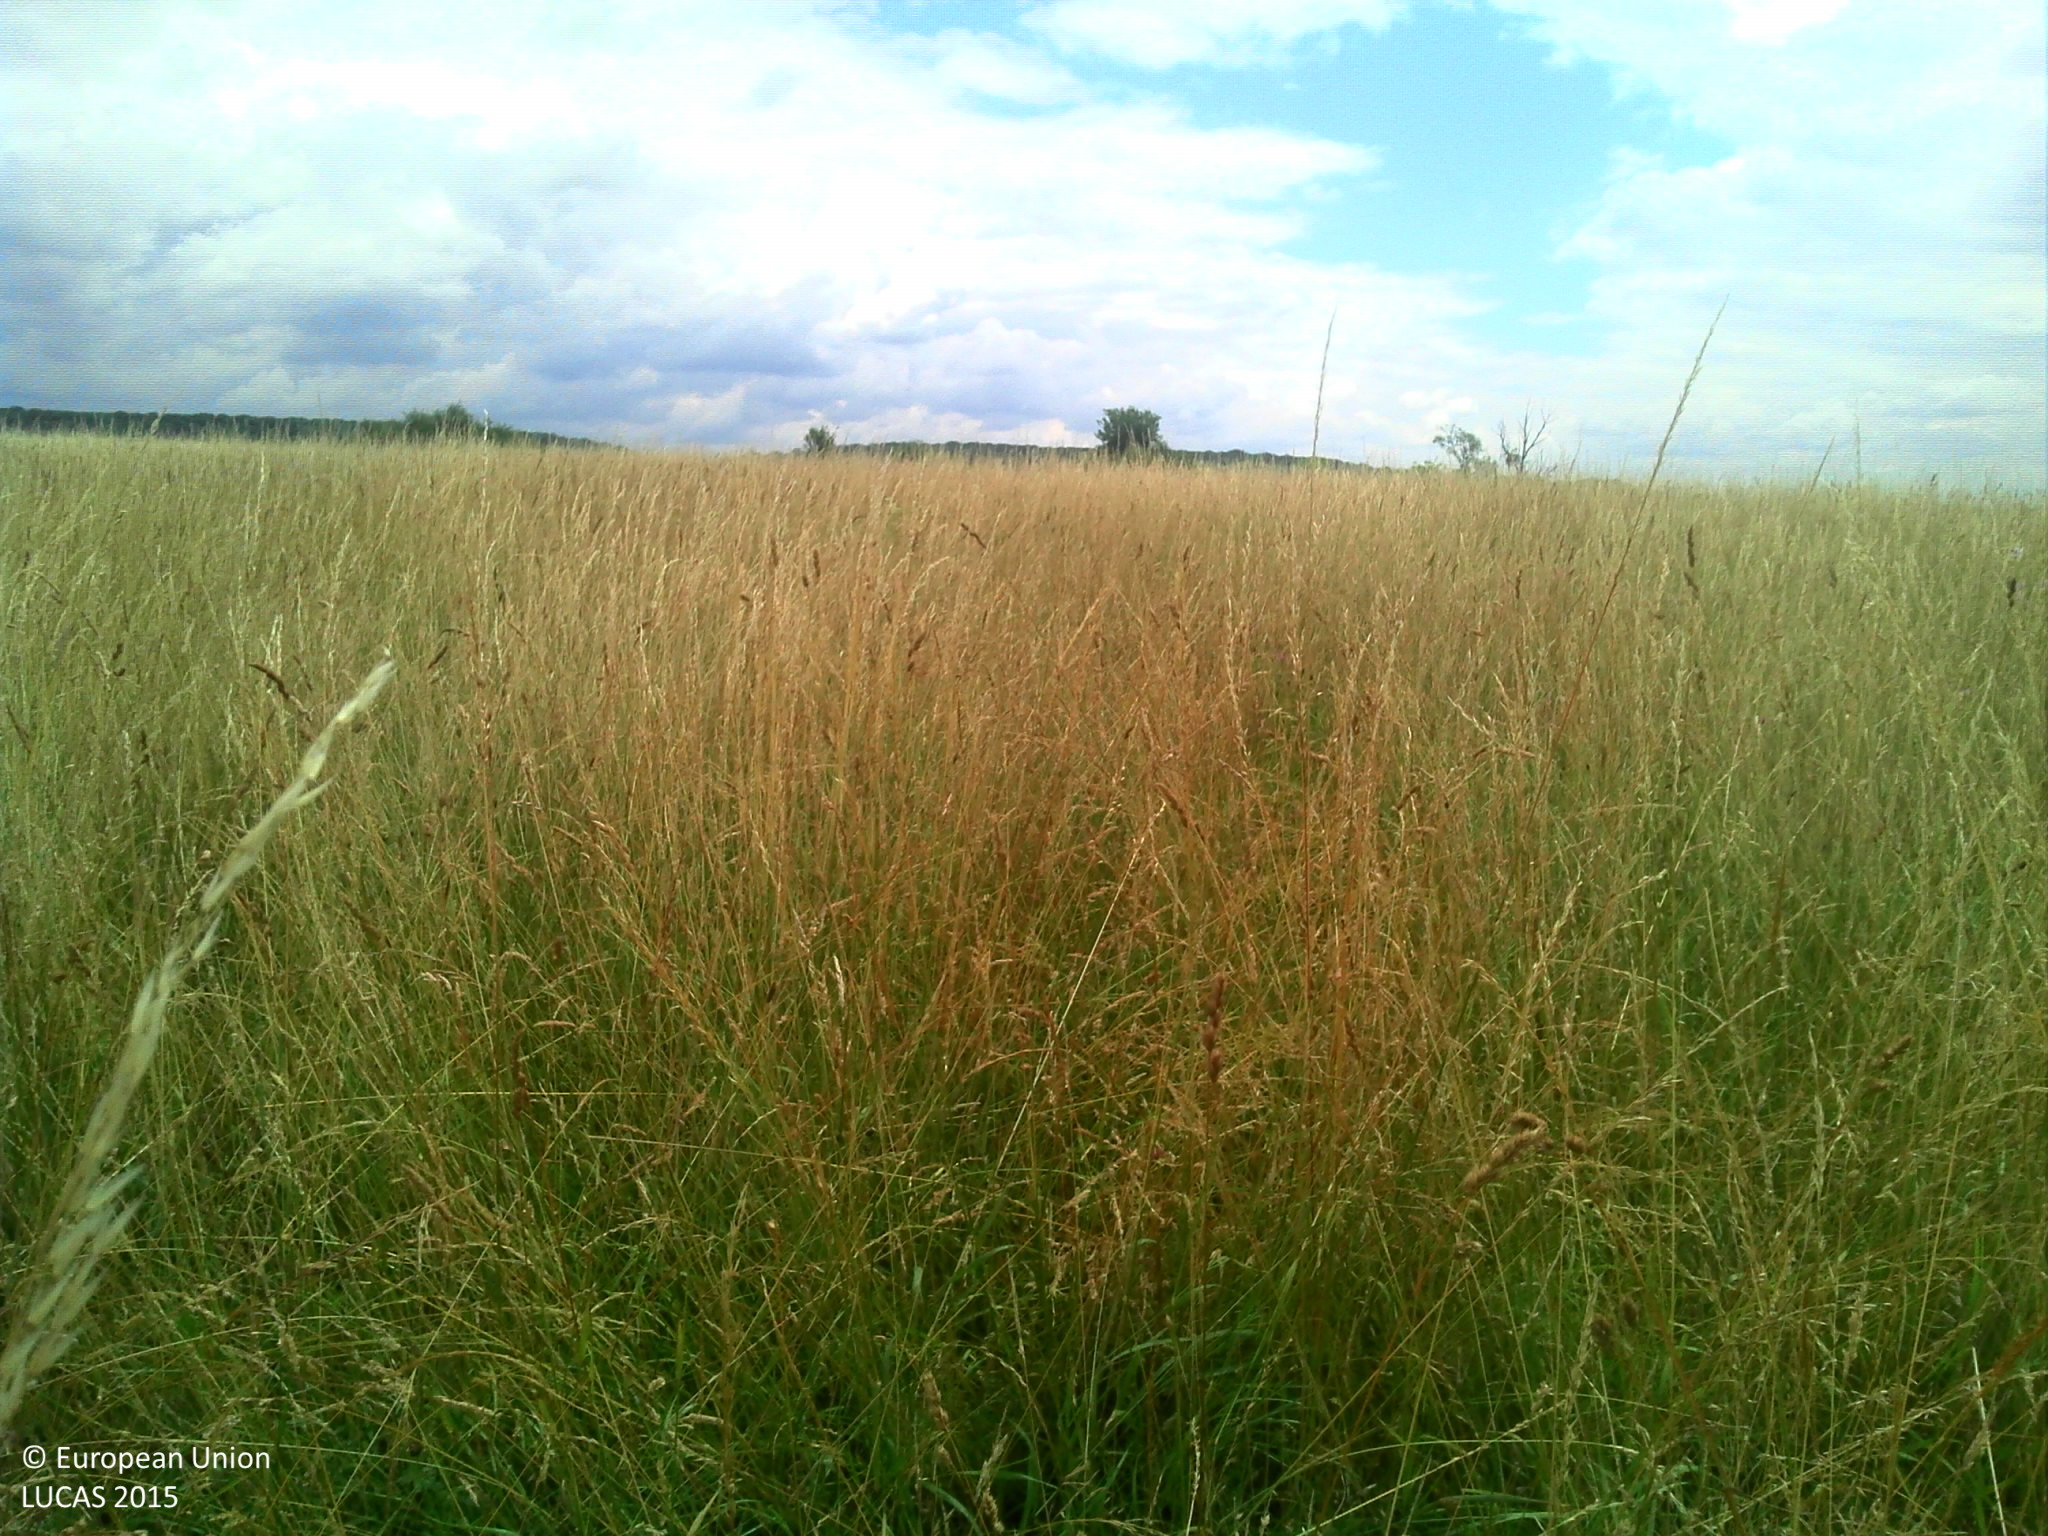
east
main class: Cropland
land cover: Temporary grasslands
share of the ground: > 75 %
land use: Agriculture (excluding fallow land and kitchen gardens)
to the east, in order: Temporary grasslands; Maize; Grass margins; Abandoned hedges; Fences; Grassland with sparse tree/shrub cover
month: June
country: FR
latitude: 47.6584
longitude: 6.3396
